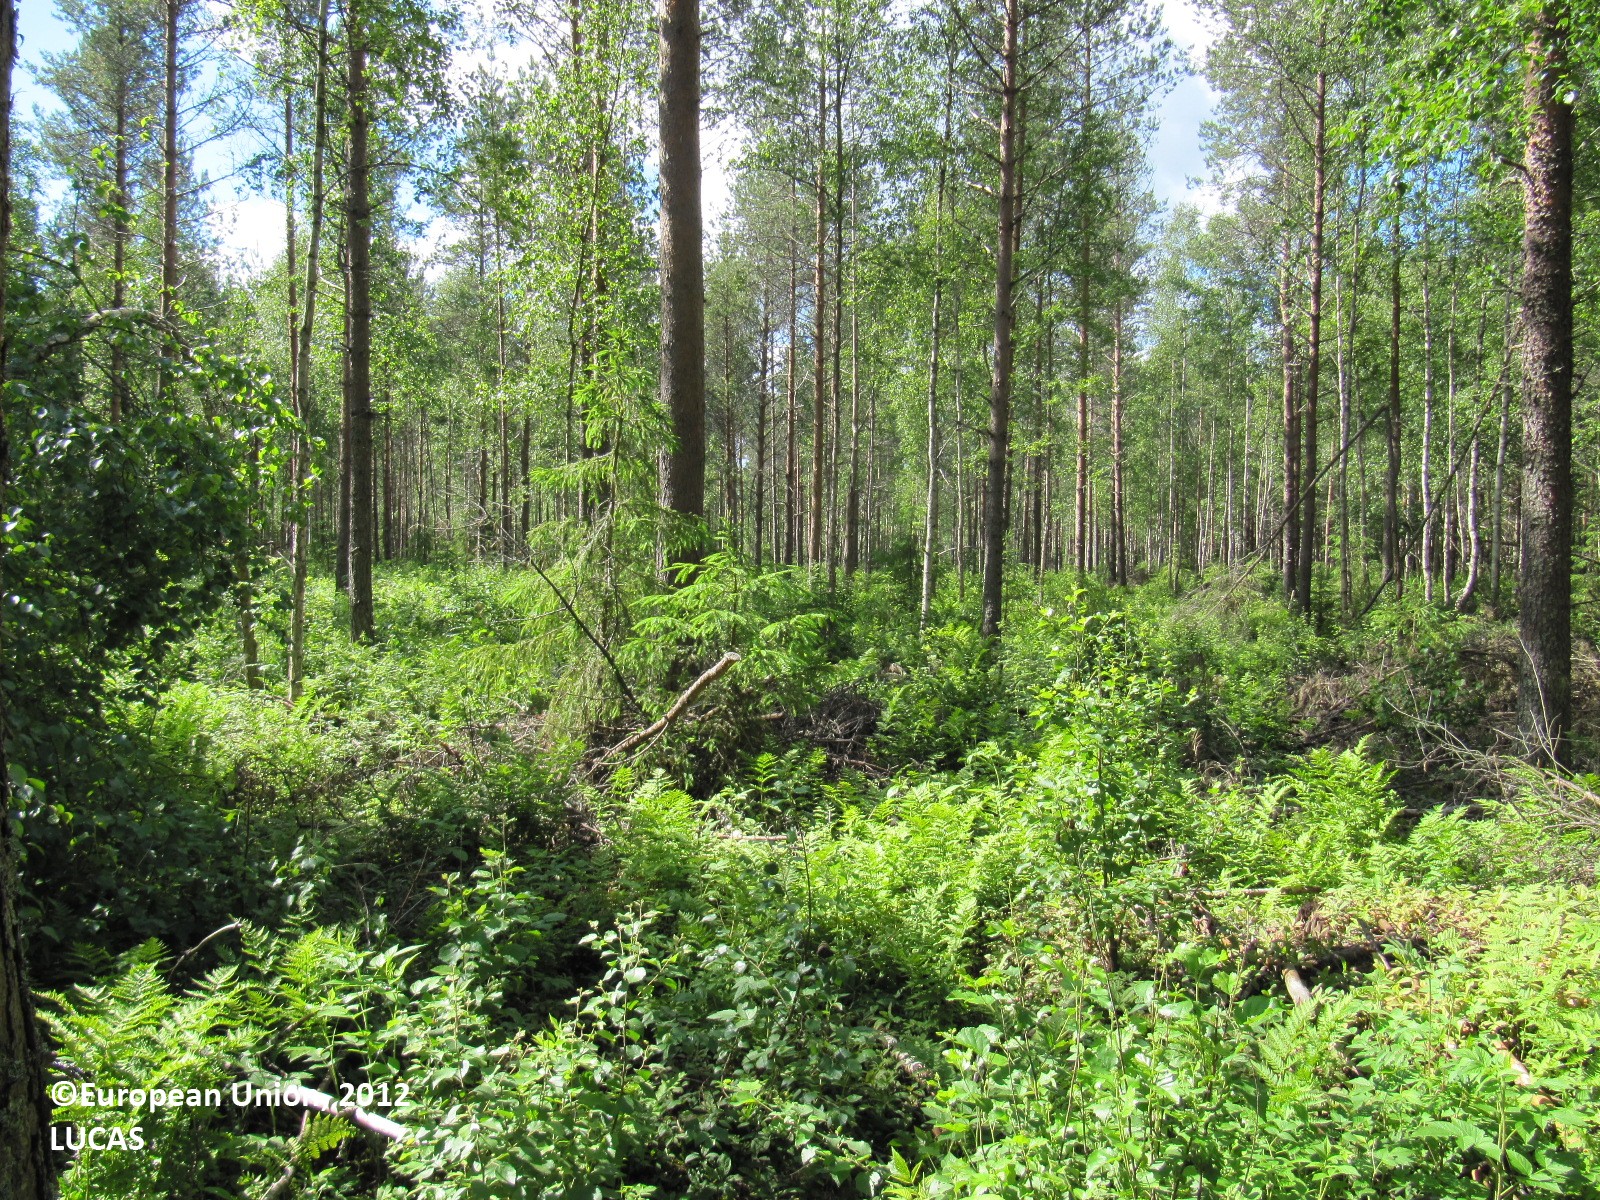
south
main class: Woodland
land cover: Pine dominated mixed woodland
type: boreal forest
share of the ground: > 75 %
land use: Forestry
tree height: > 5 m
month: June
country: FI
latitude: 60.6032
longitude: 24.2920
